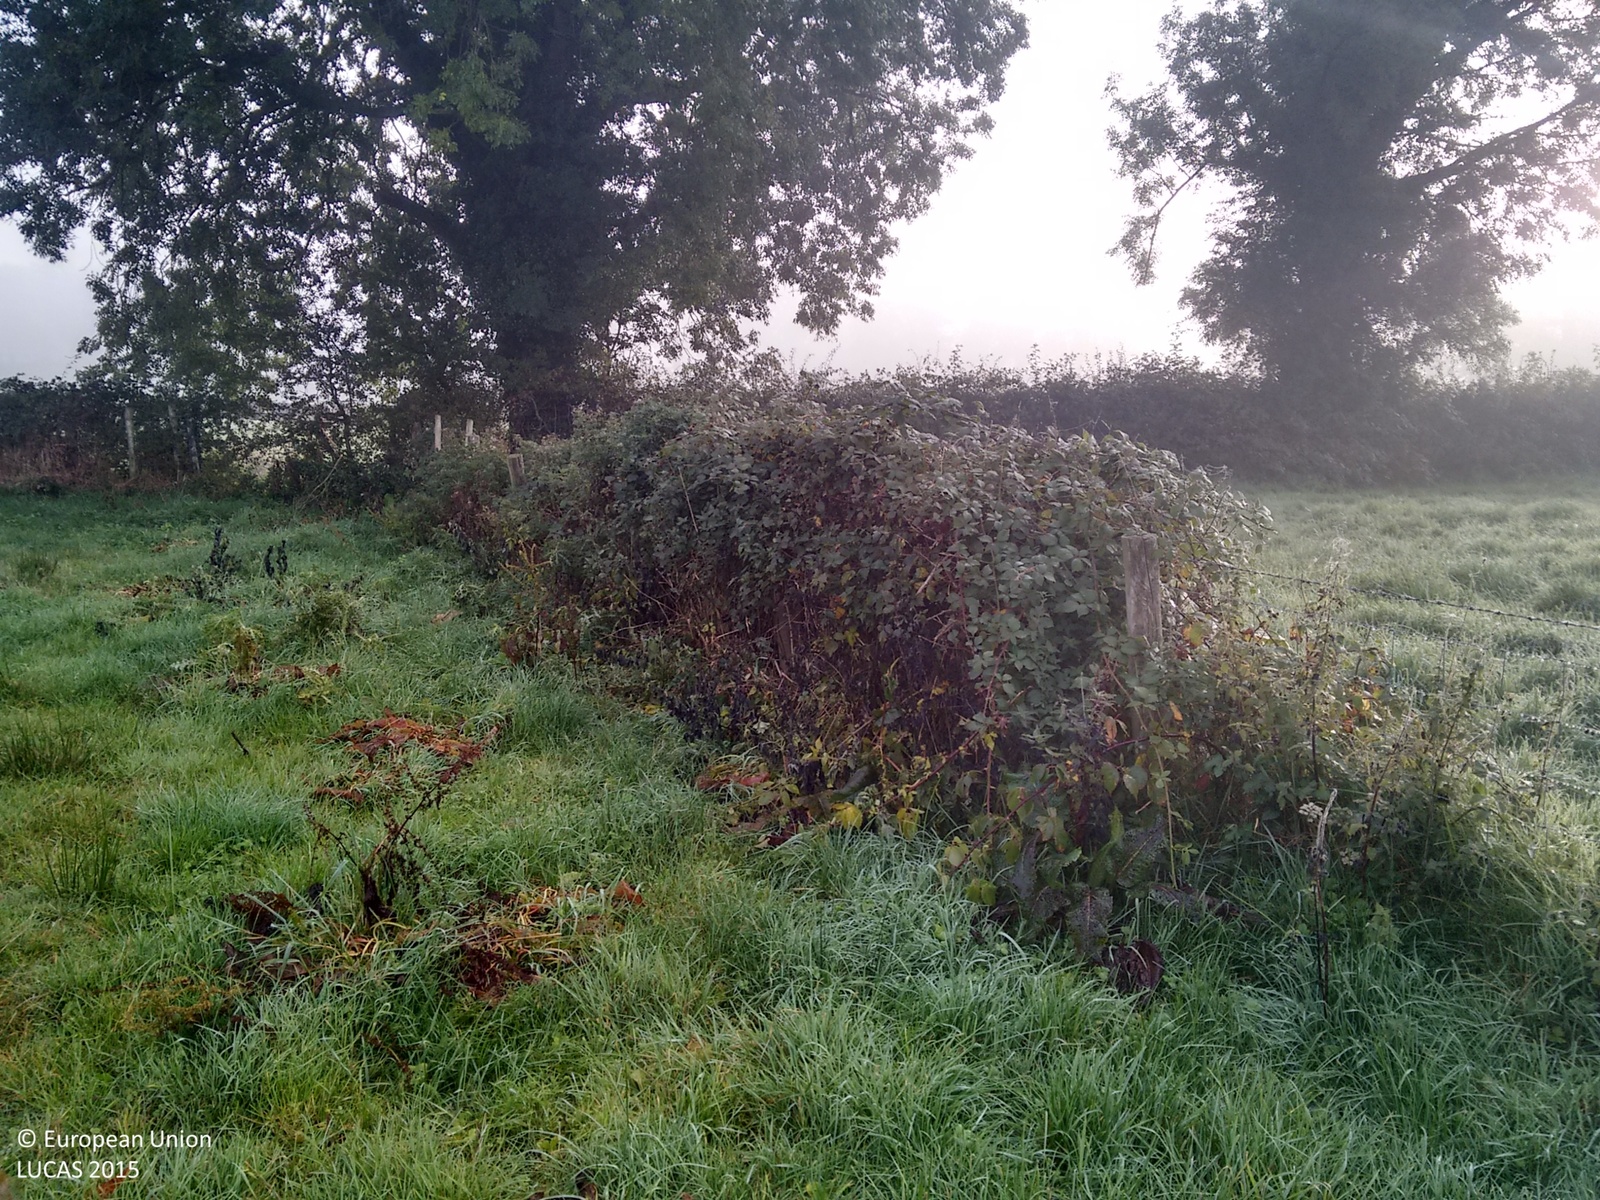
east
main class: Grassland
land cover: Grassland without tree/shrub cover
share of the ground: > 75 %
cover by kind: herbaceous plants 100 %
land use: Agriculture (excluding fallow land and kitchen gardens)
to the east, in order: Grassland without tree/shrub cover; Fences; Grassland without tree/shrub cover; Ditches and canals; Fences; Managed hedges; Grassland without tree/shrub cover; Abandoned hedges; Fences; Grassland without tree/shrub cover; Abandoned hedges; Fences; Grassland without tree/shrub cover
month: October
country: GB
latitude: 54.2878
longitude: -7.7543
